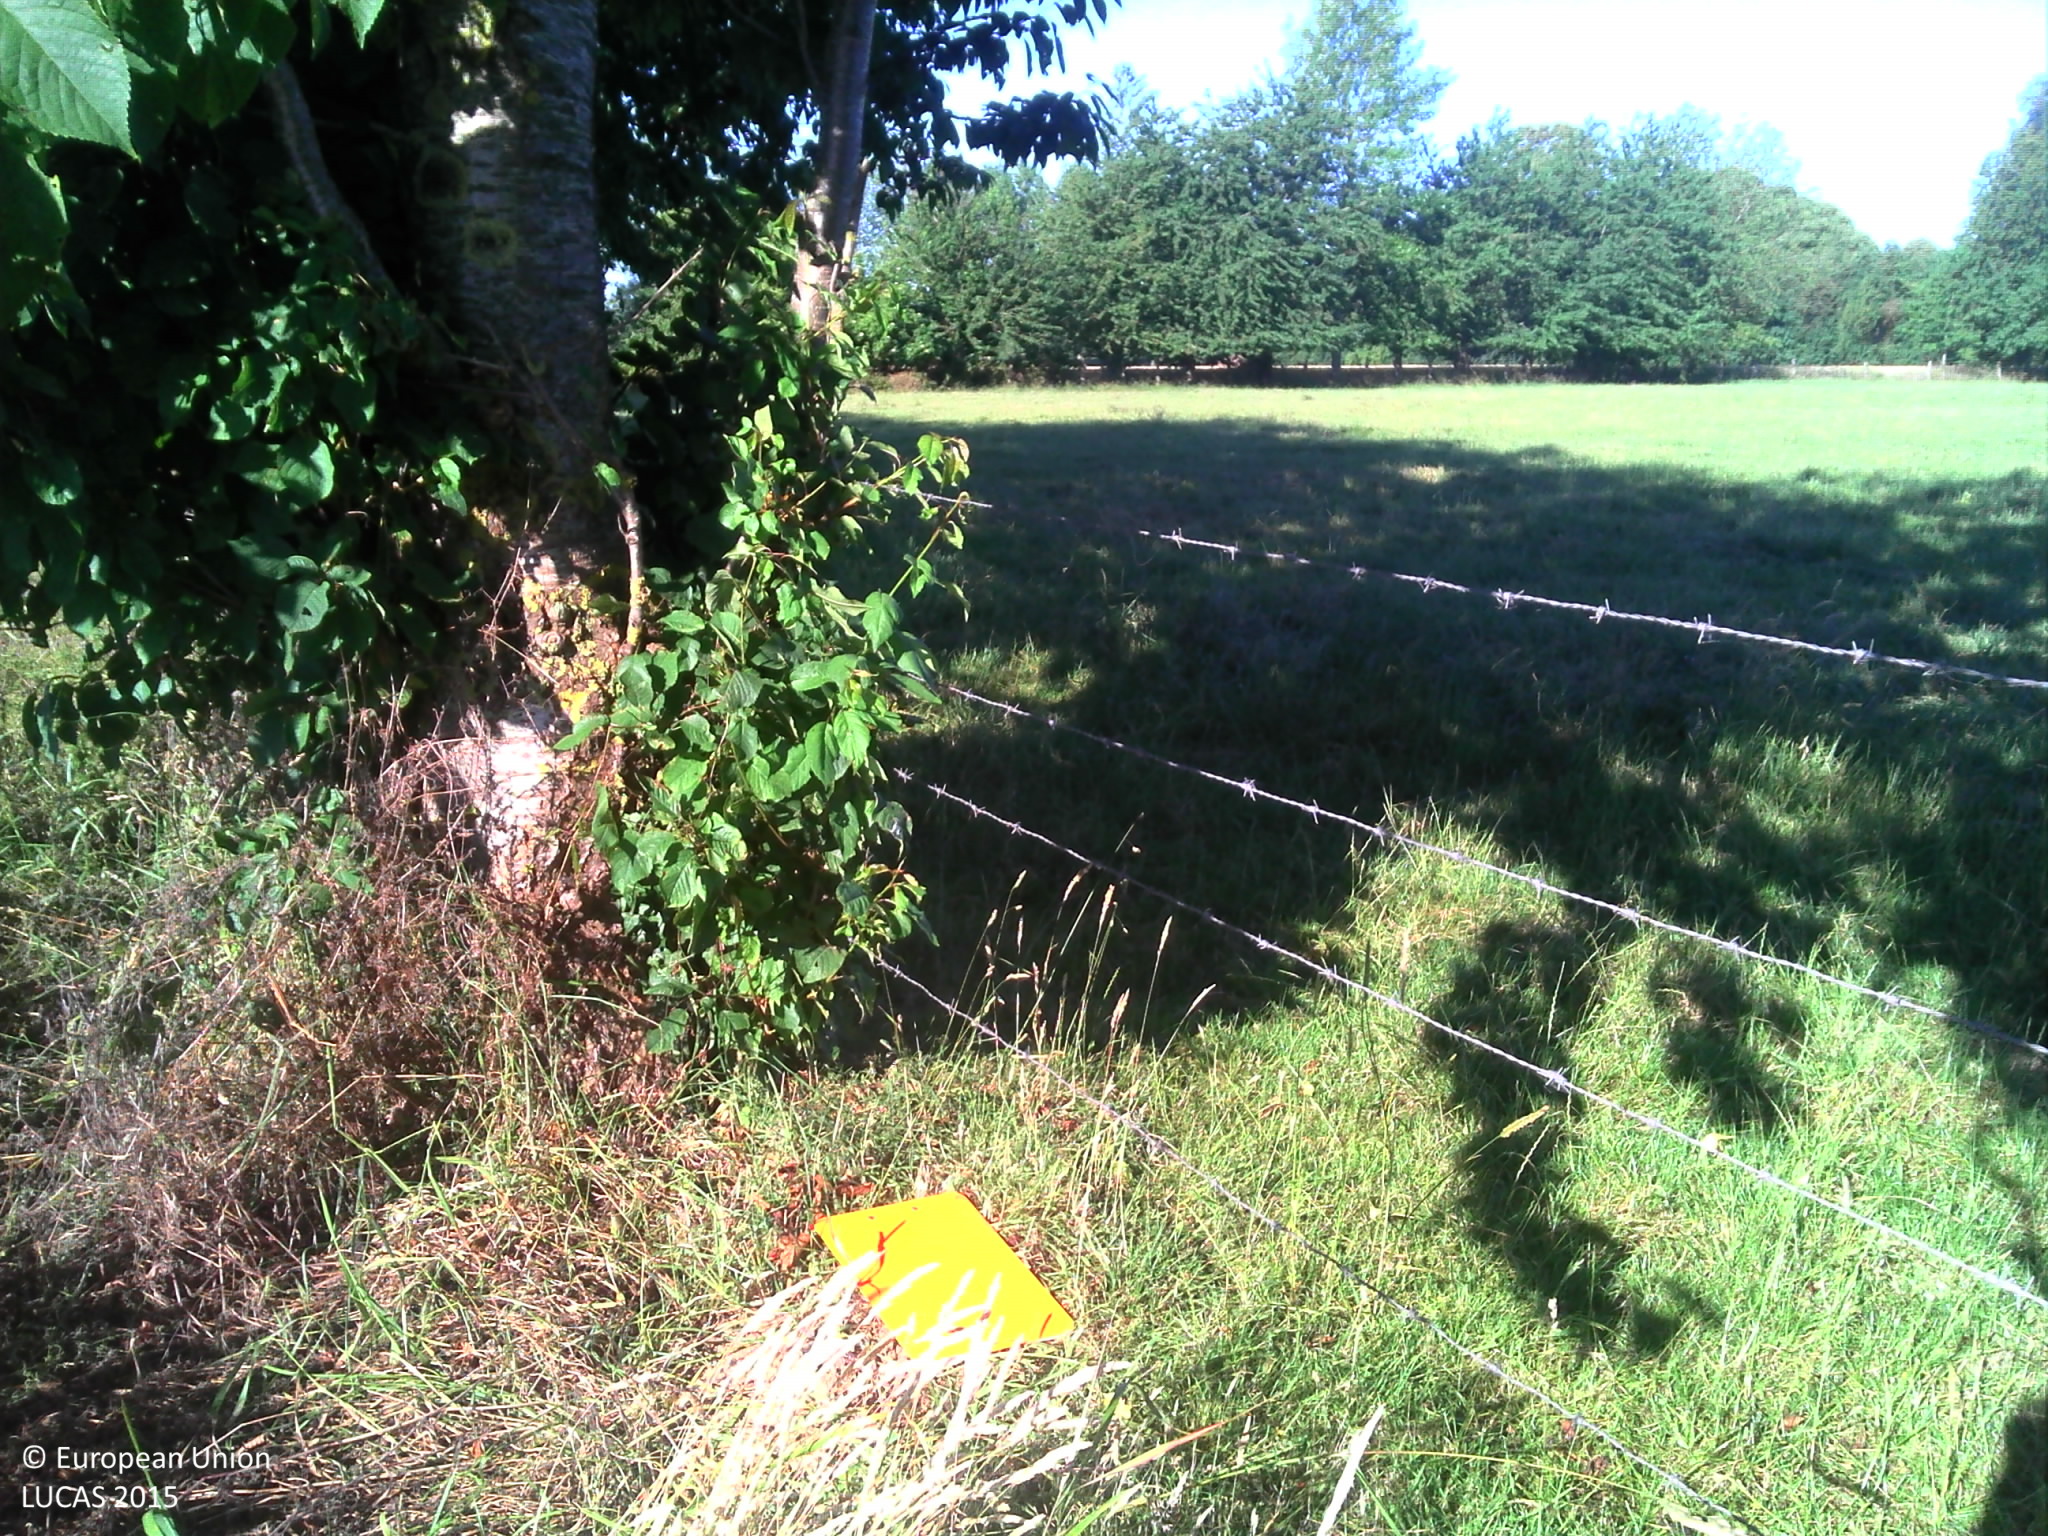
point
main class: Grassland
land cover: Grassland without tree/shrub cover
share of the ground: > 75 %
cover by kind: herbaceous plants 100 %
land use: Agriculture (excluding fallow land and kitchen gardens)
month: July
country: FR
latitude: 49.9528
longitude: 1.6897
